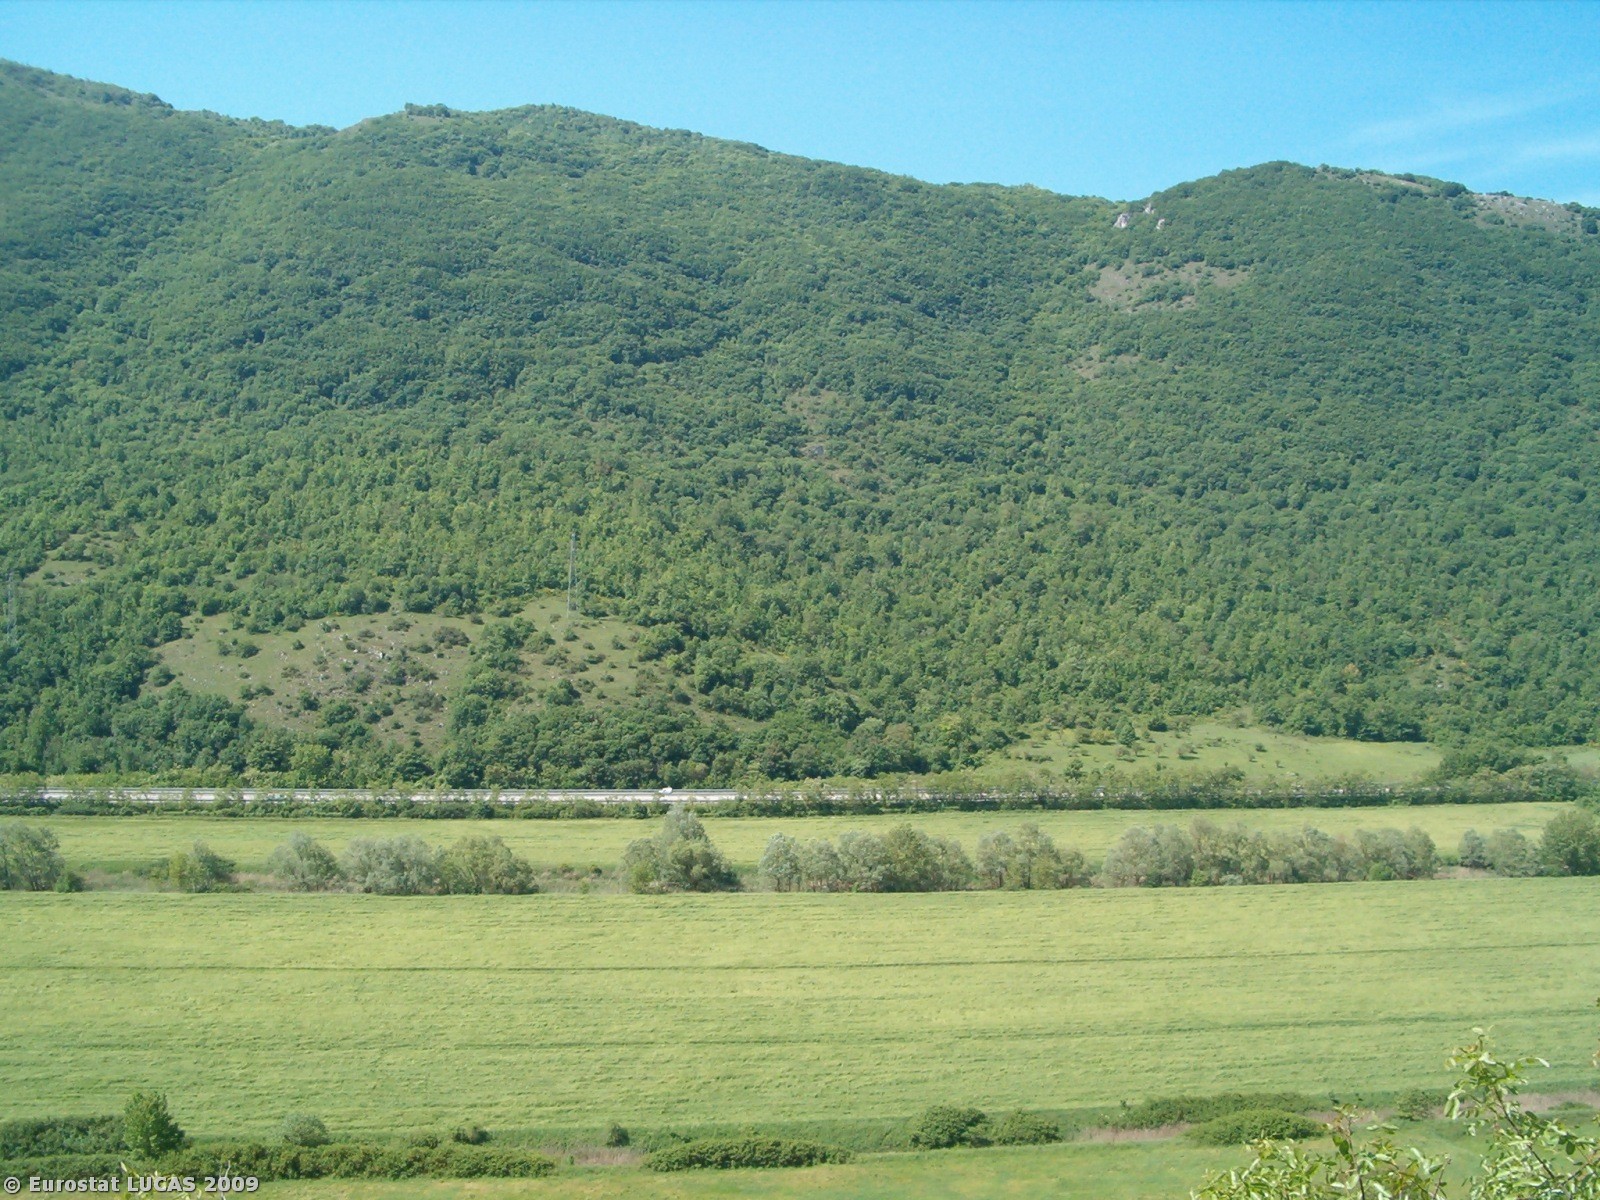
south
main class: Shrubland
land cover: Shrubland without tree cover
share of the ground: > 75 %
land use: Unused
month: May
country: IT
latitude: 42.1117
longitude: 13.3145
